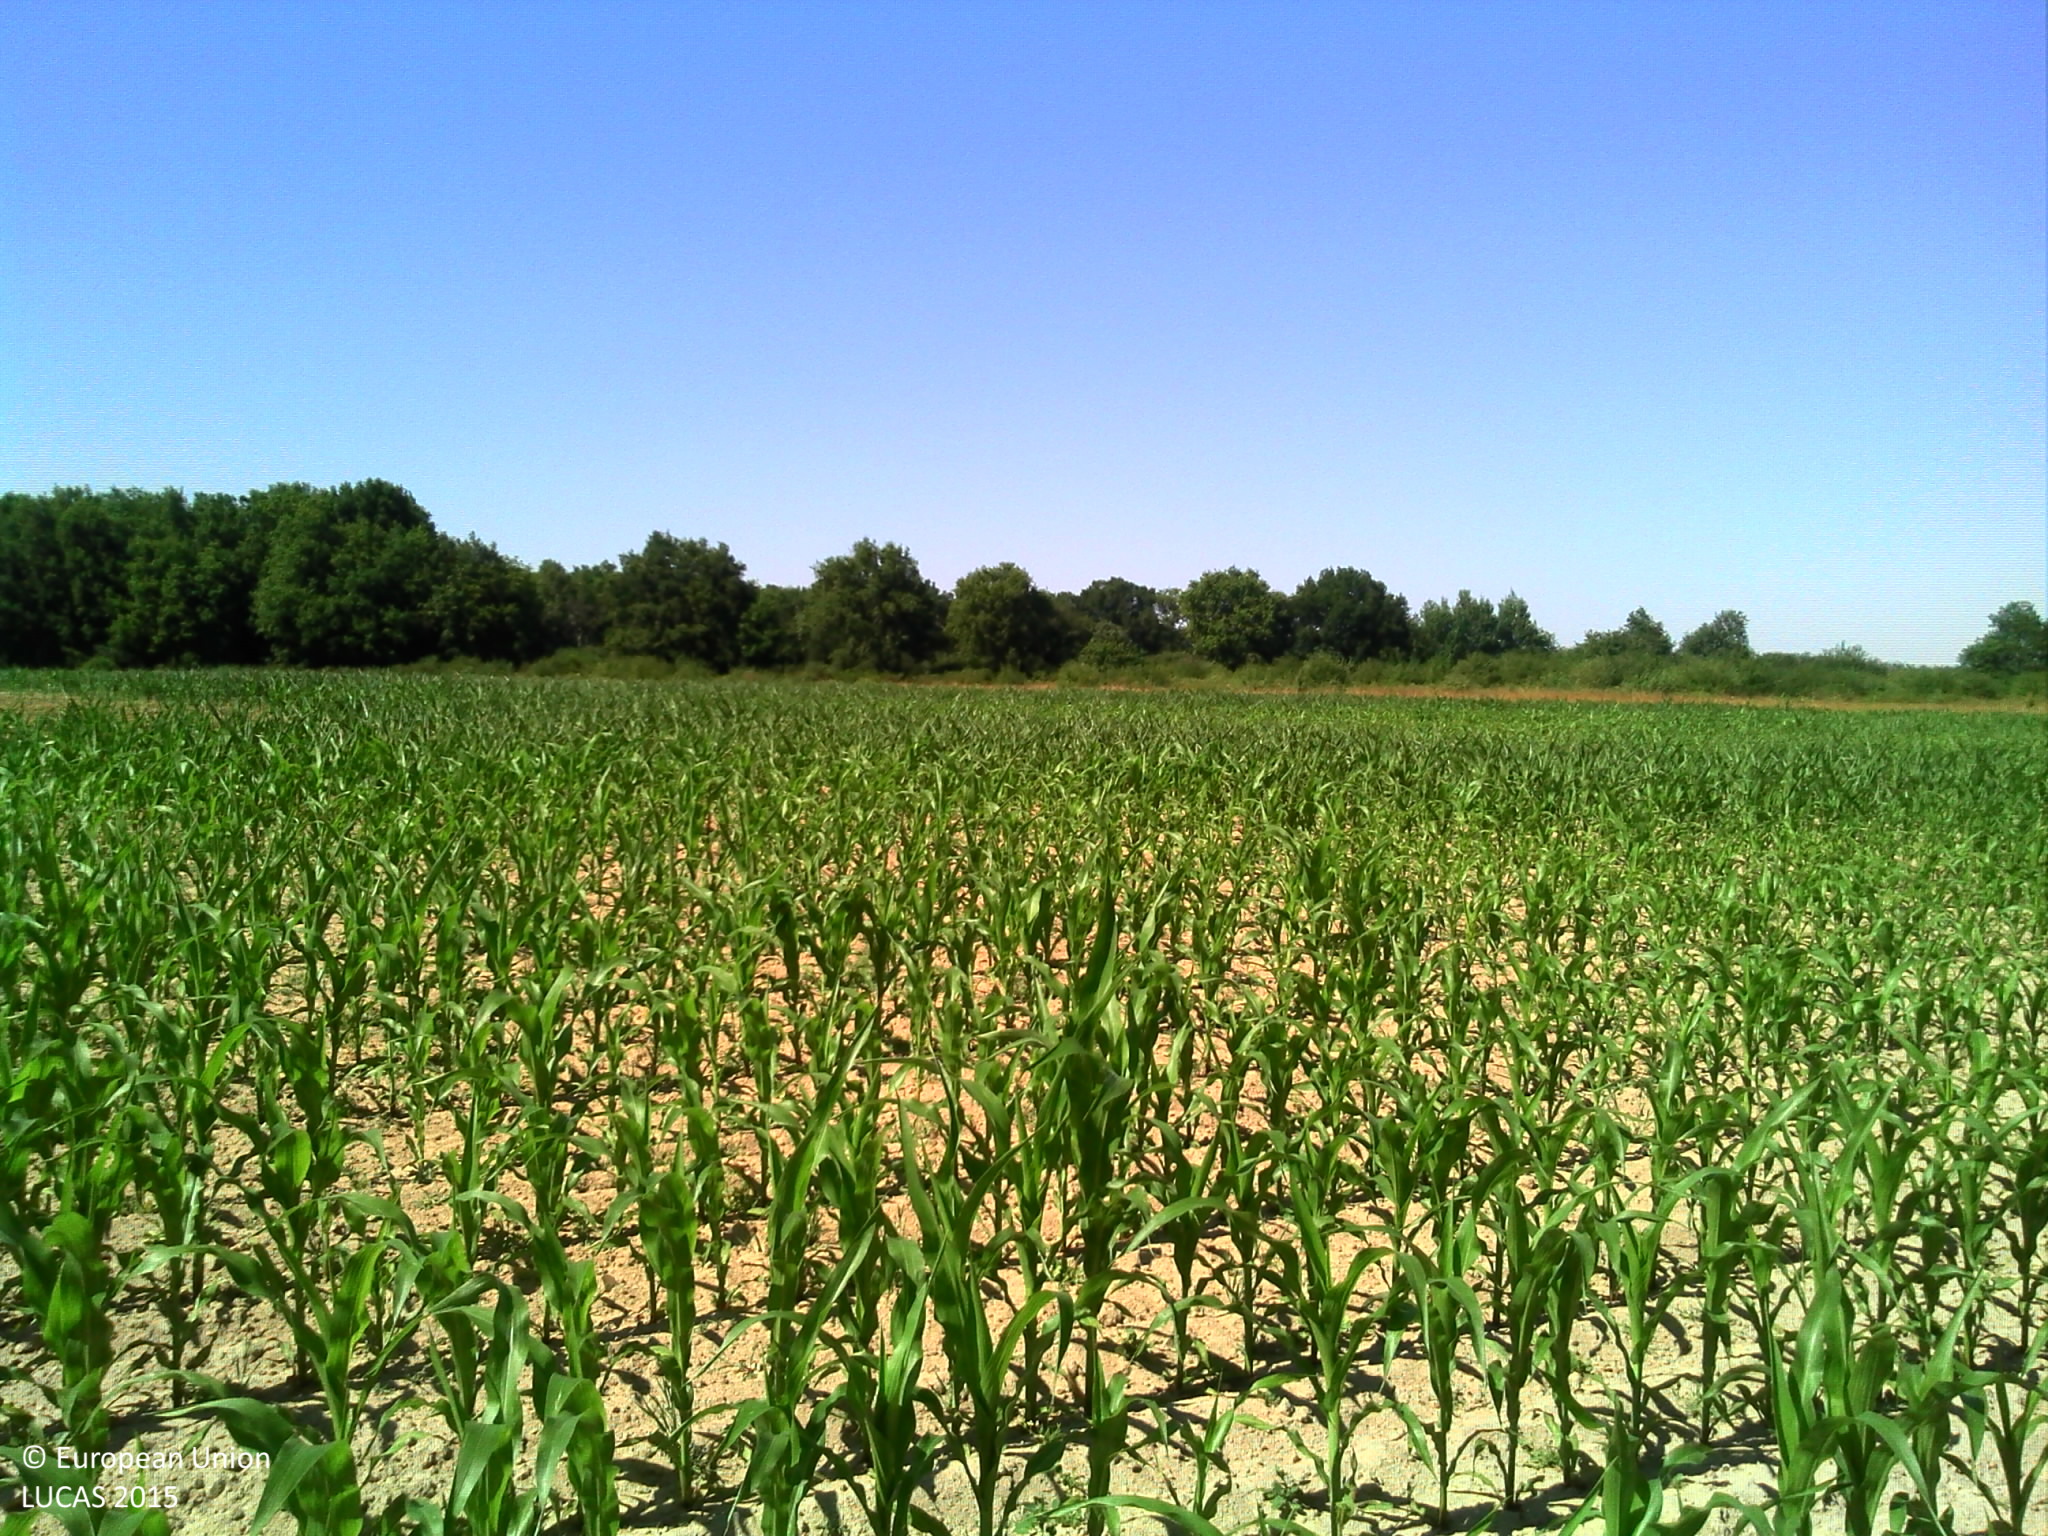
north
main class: Cropland
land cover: Maize
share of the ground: 25 - 50 %
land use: Agriculture (excluding fallow land and kitchen gardens)
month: July
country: FR
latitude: 47.9323
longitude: 2.5085
